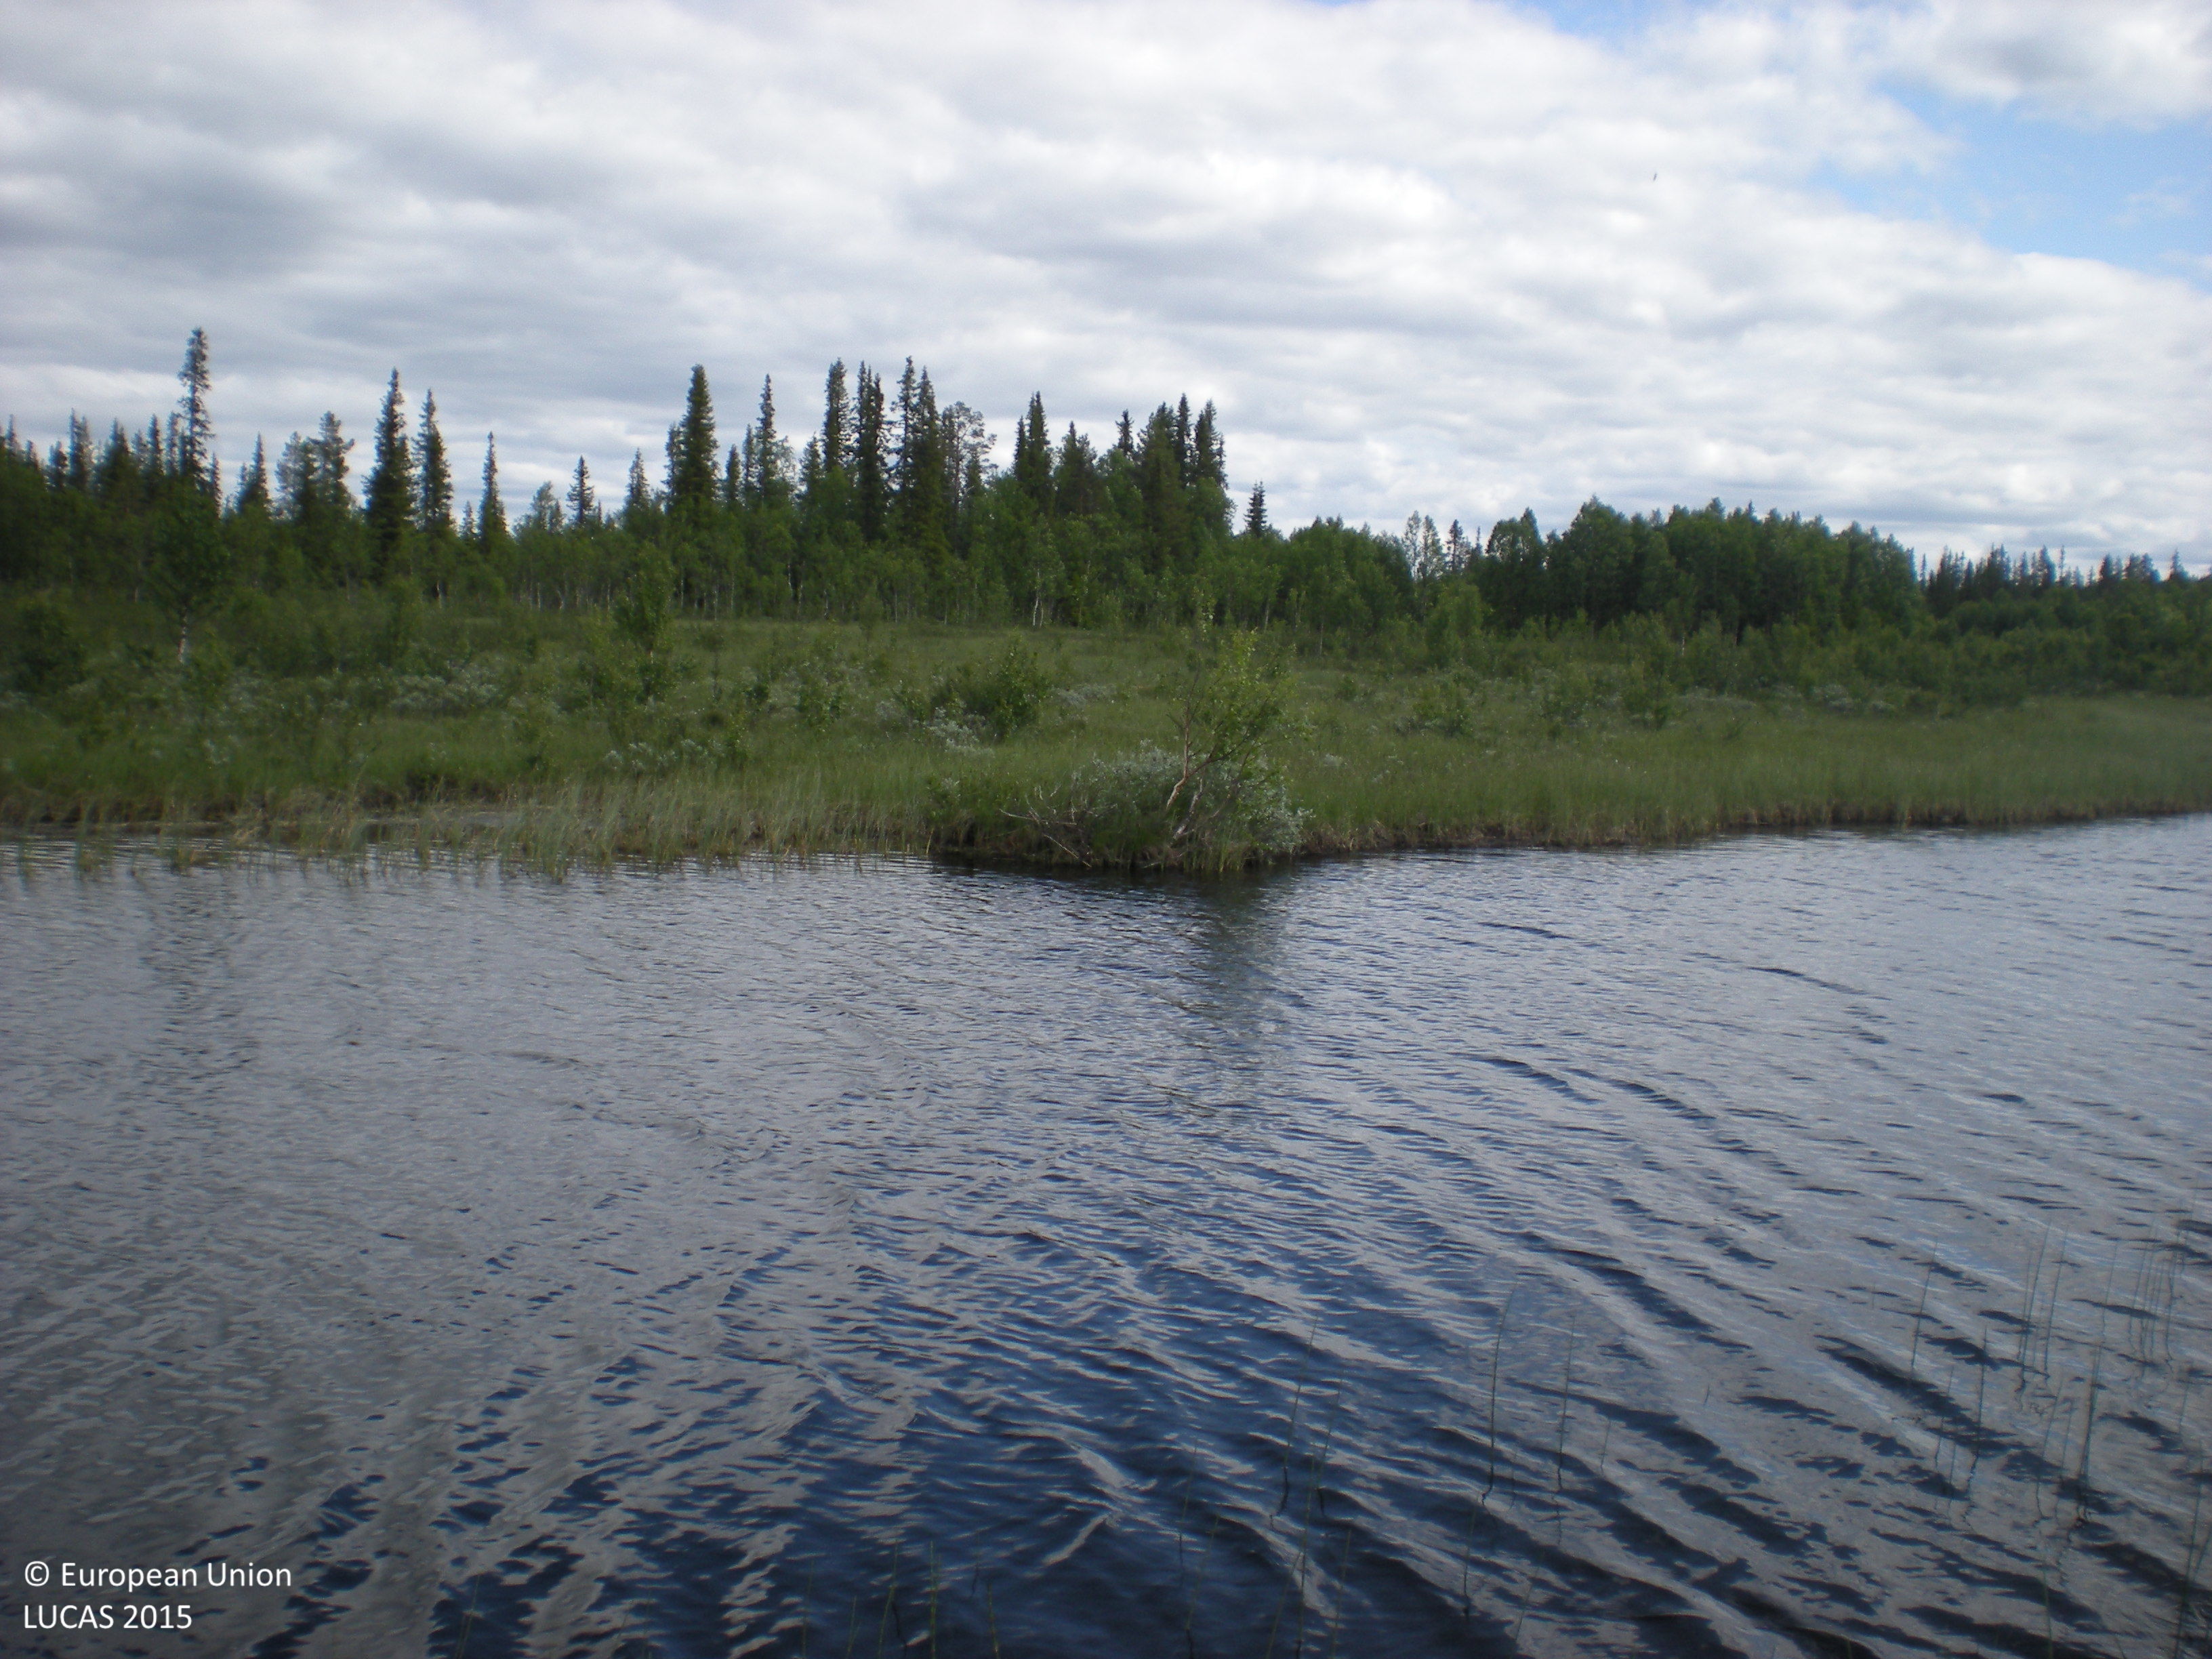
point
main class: Woodland
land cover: Broadleaved woodland
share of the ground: 10 - 25 %
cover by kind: herbaceous plants 70 %, broadleaved forest trees 30 %
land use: Semi-natural and natural areas not in use
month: July
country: SE
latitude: 65.4660
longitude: 16.8460
